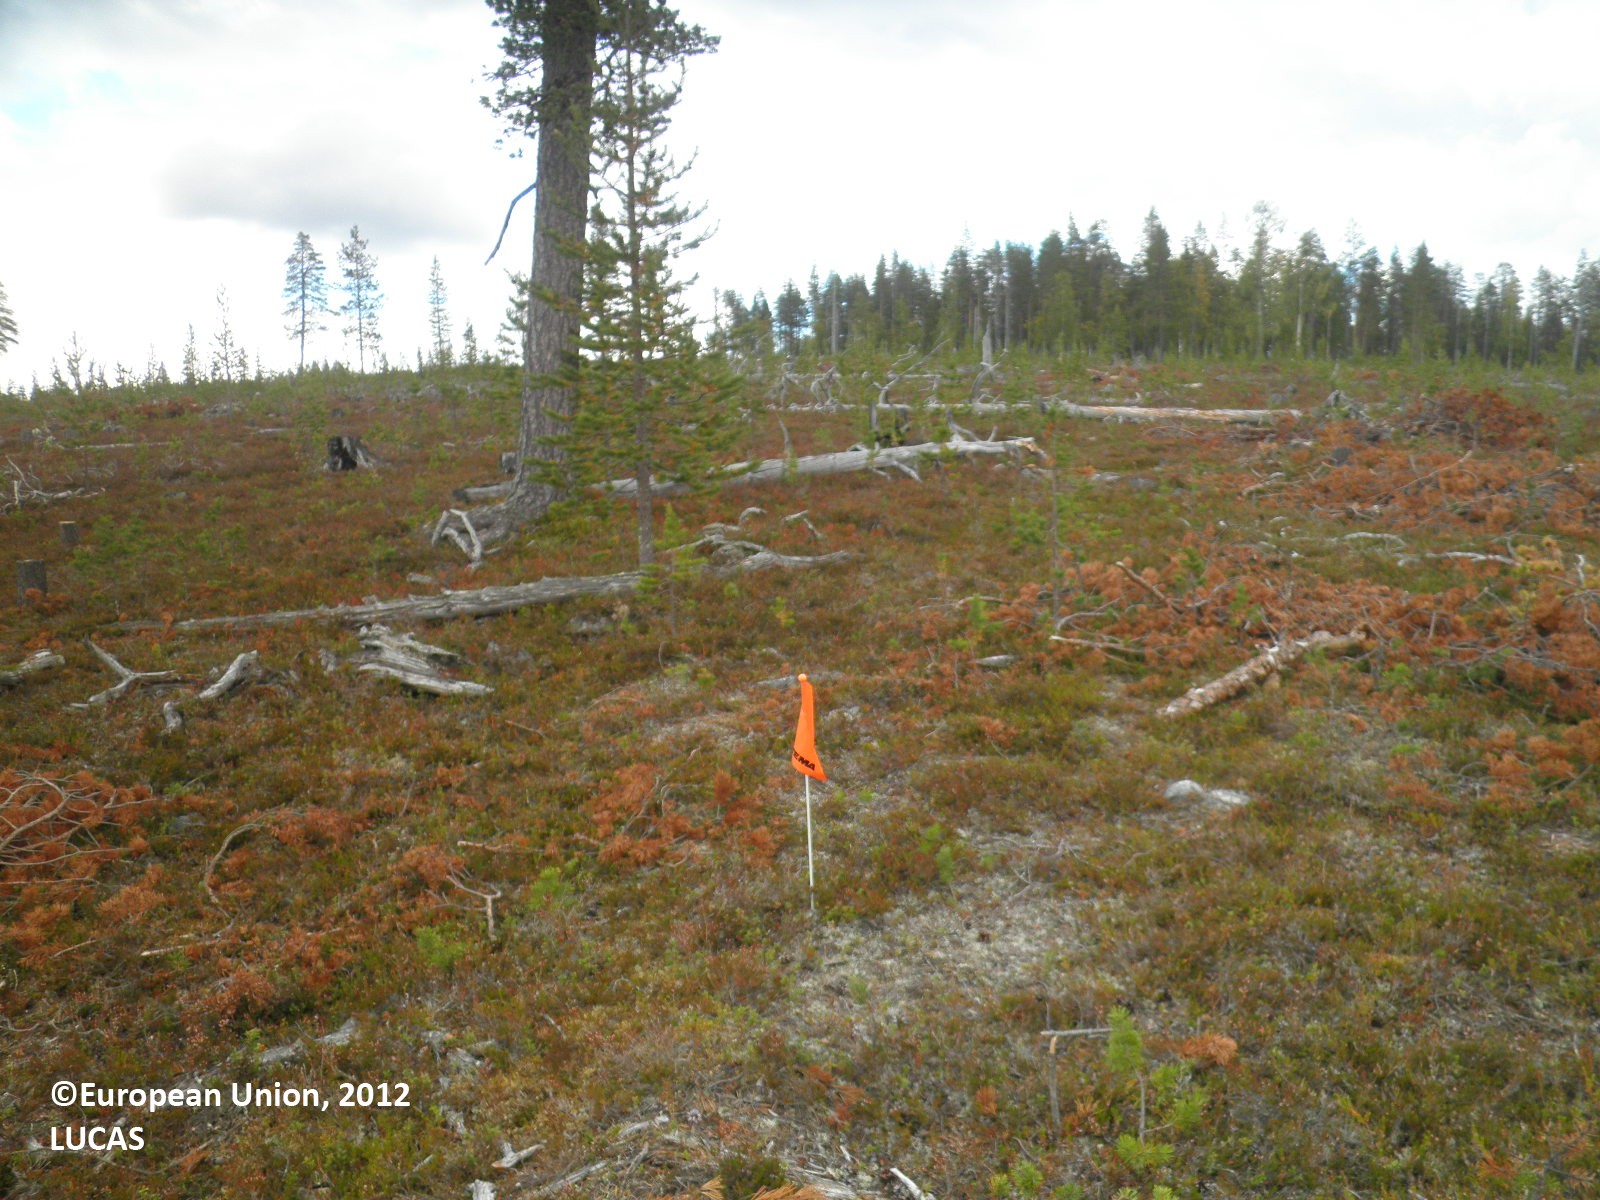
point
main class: Woodland
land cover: Pine dominated coniferous woodland
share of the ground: 10 - 25 %
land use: Forestry
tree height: < 5 m
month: August
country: FI
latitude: 67.9261
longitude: 28.2588
